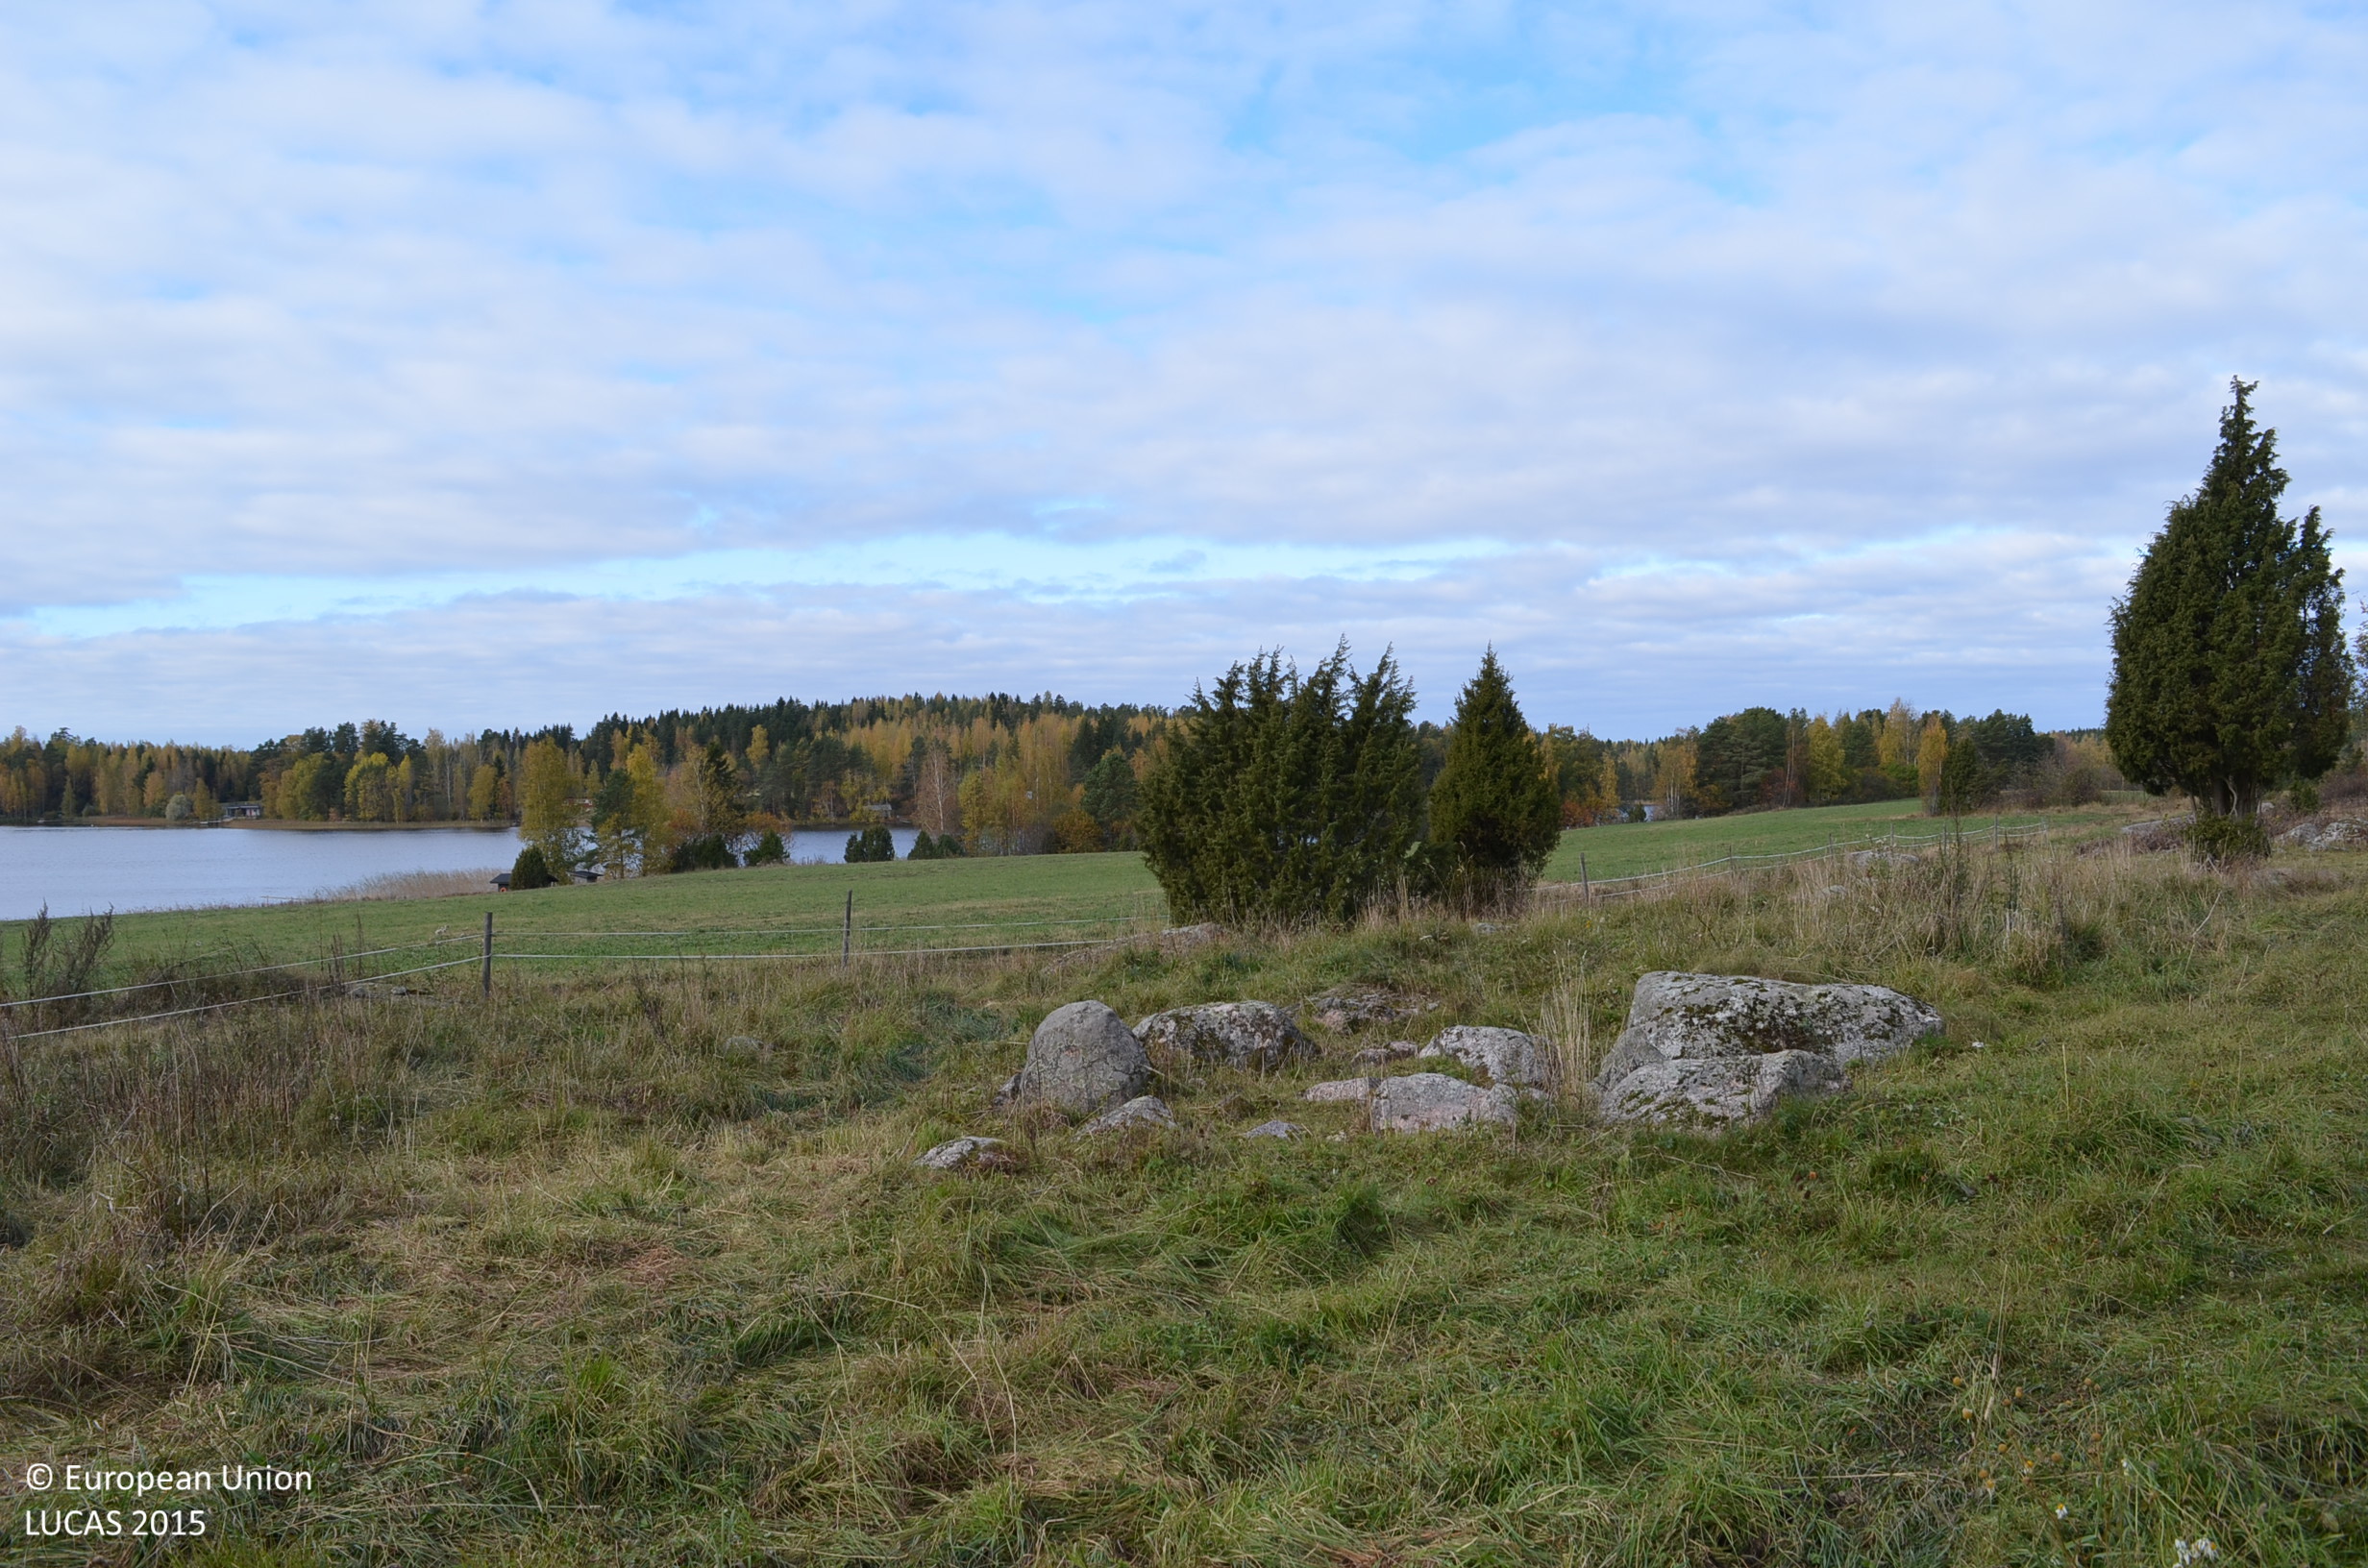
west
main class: Grassland
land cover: Grassland with sparse tree/shrub cover
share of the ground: > 75 %
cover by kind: herbaceous plants 80 %, unconsolidated bare surface 10 %, coniferous forest trees 5 %, shrubs 5 %
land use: Fallow land
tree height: > 5 m
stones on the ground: < 10 %
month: October
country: FI
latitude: 61.6597
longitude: 23.8121
